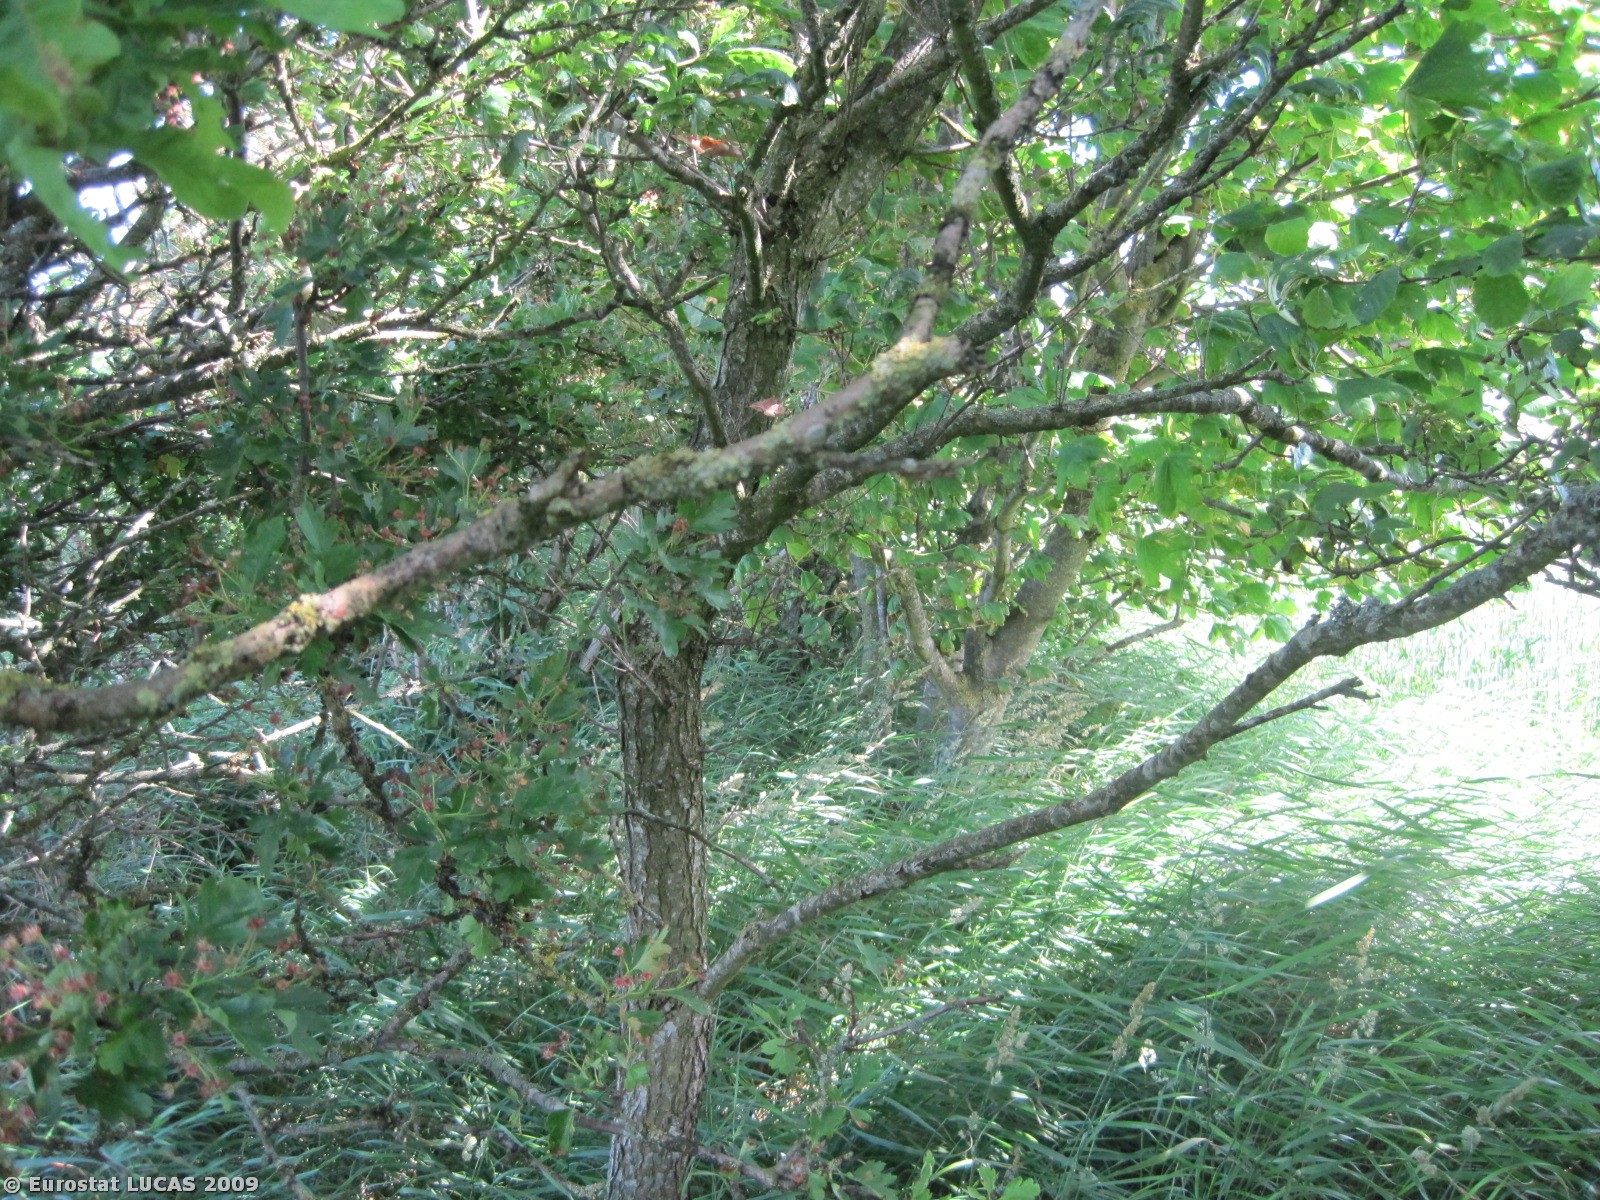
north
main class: Woodland
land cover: Broadleaved woodland
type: plantations and self-sown exotic forest
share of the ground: > 75 %
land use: Unused
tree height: > 5 m
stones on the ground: < 10 %
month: June
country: DK
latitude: 56.9043
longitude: 9.1966
